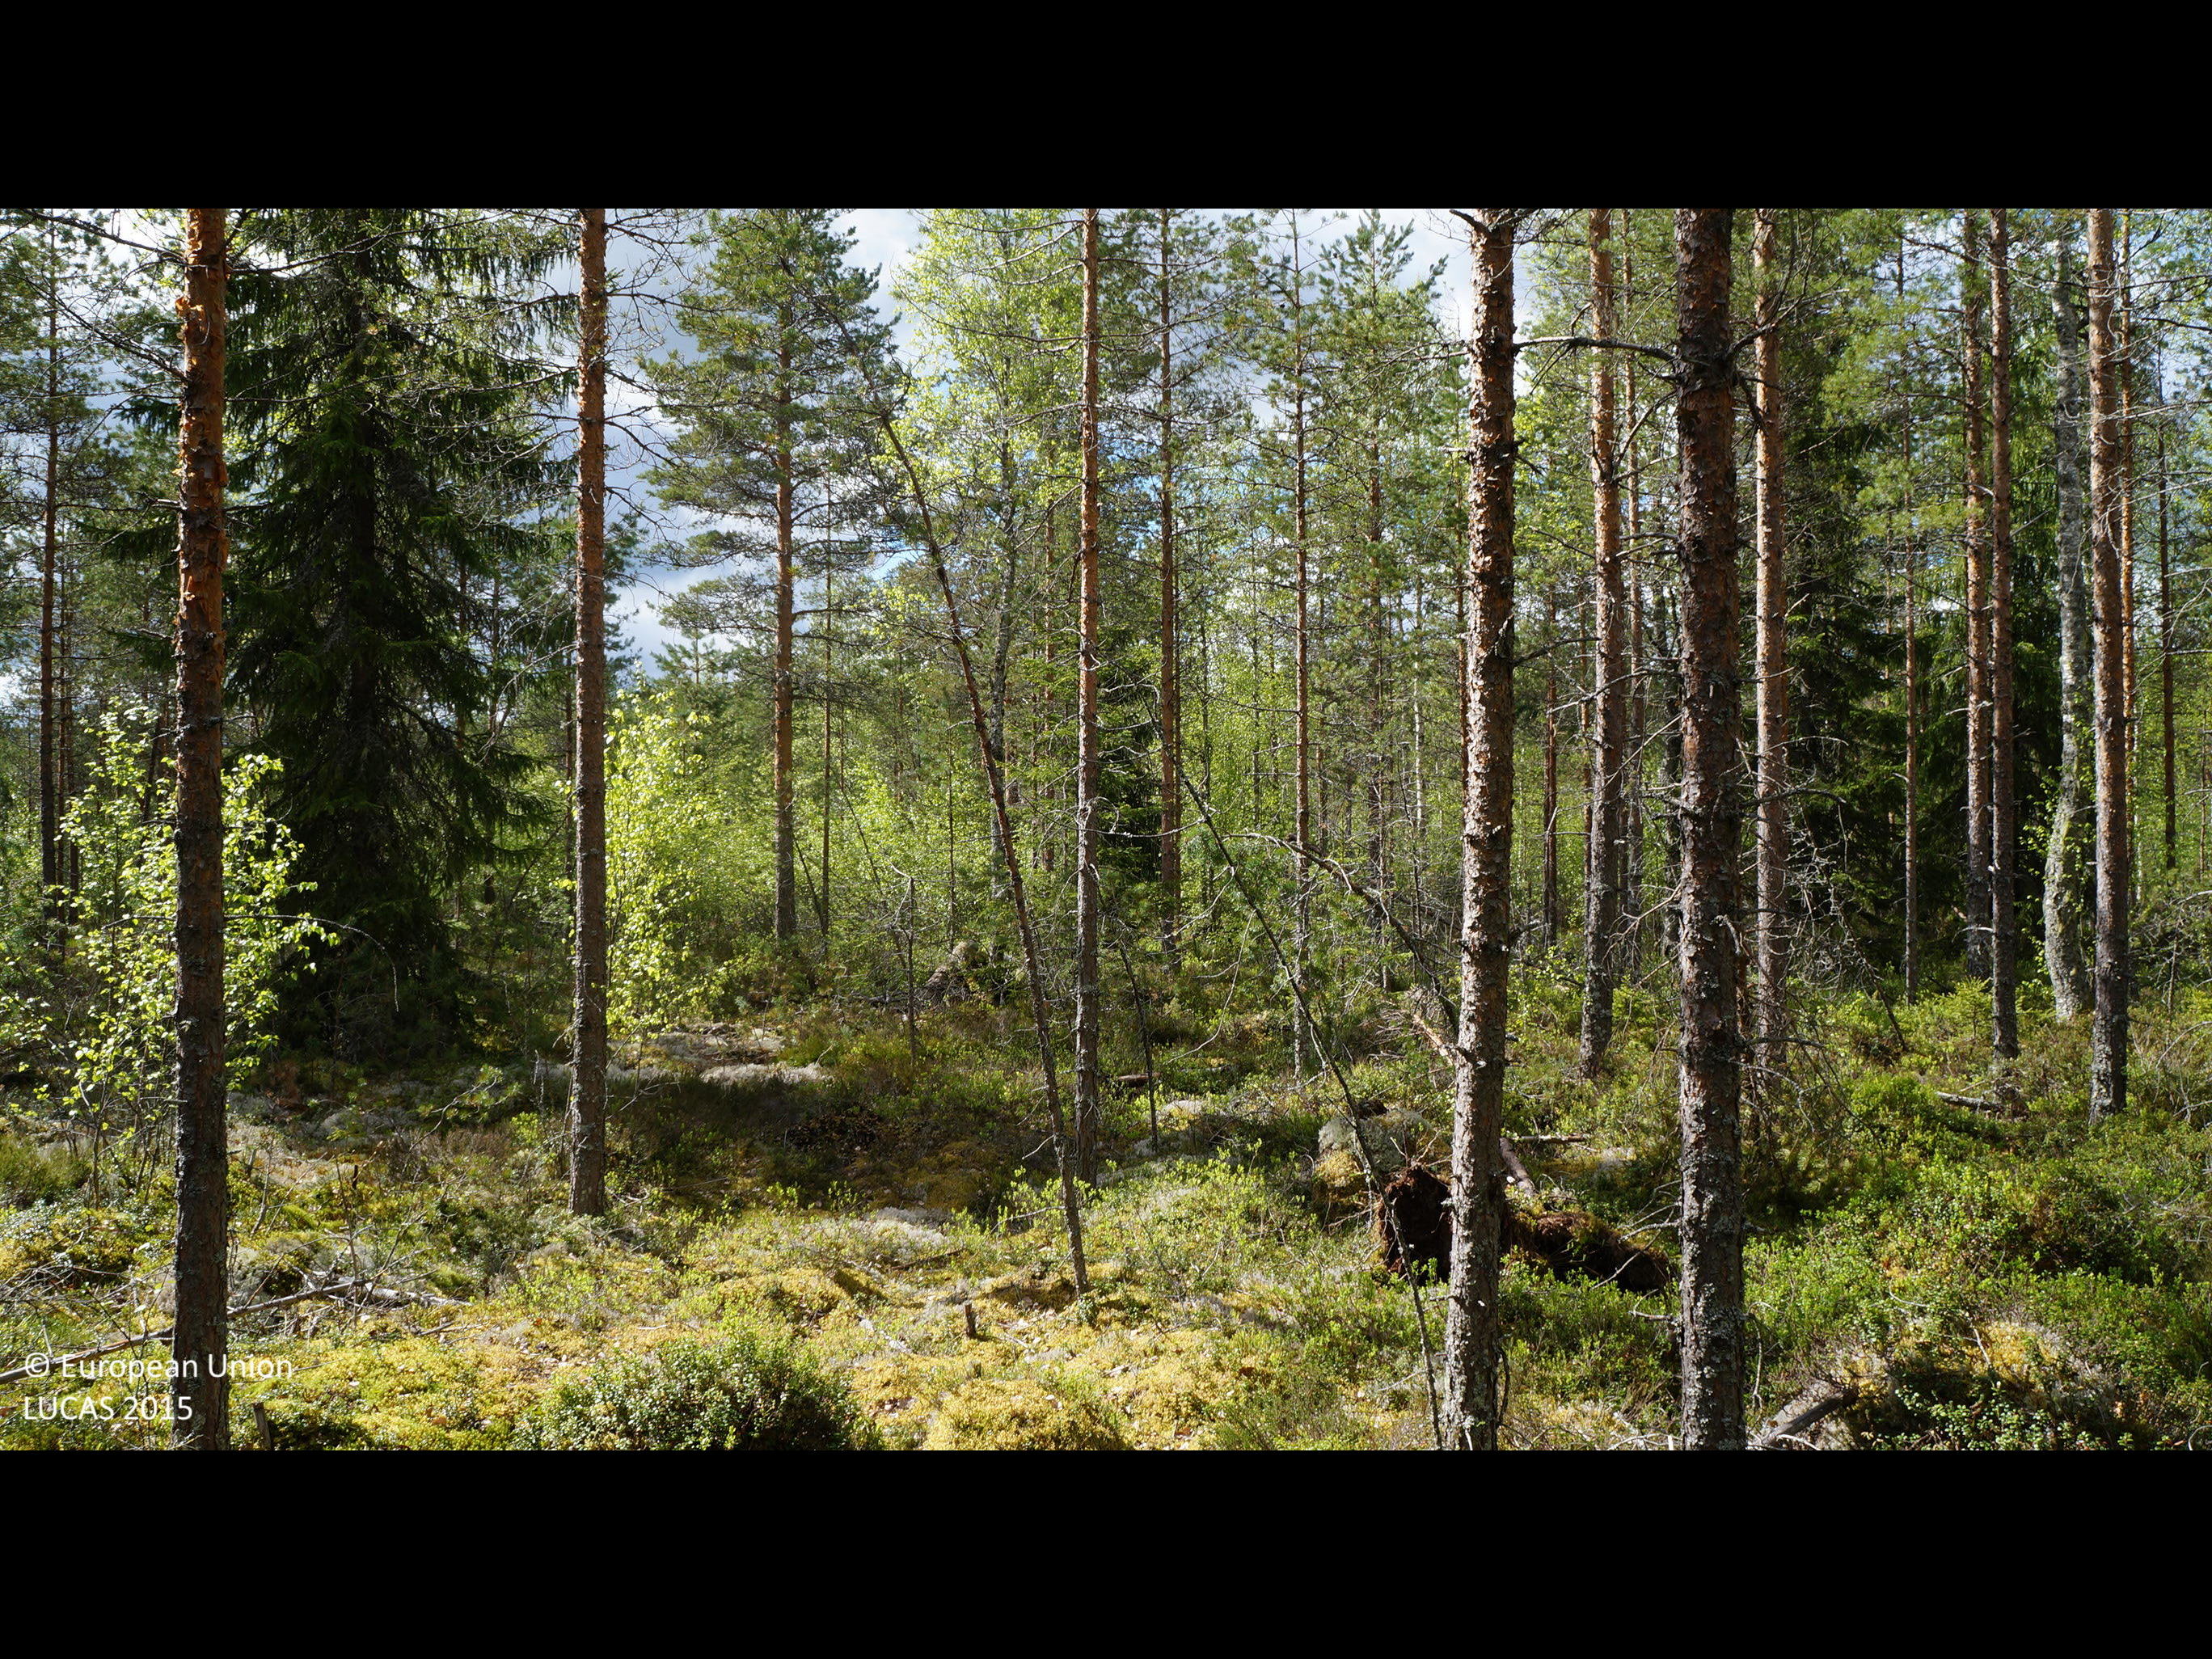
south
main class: Woodland
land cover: Pine dominated mixed woodland
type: boreal forest
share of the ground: 50 - 75 %
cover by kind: coniferous forest trees 40 %, shrubs 25 %, broadleaved forest trees 20 %, lichens and mosses 15 %
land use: Forestry
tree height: > 5 m
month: June
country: FI
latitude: 63.8045
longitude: 24.2649
